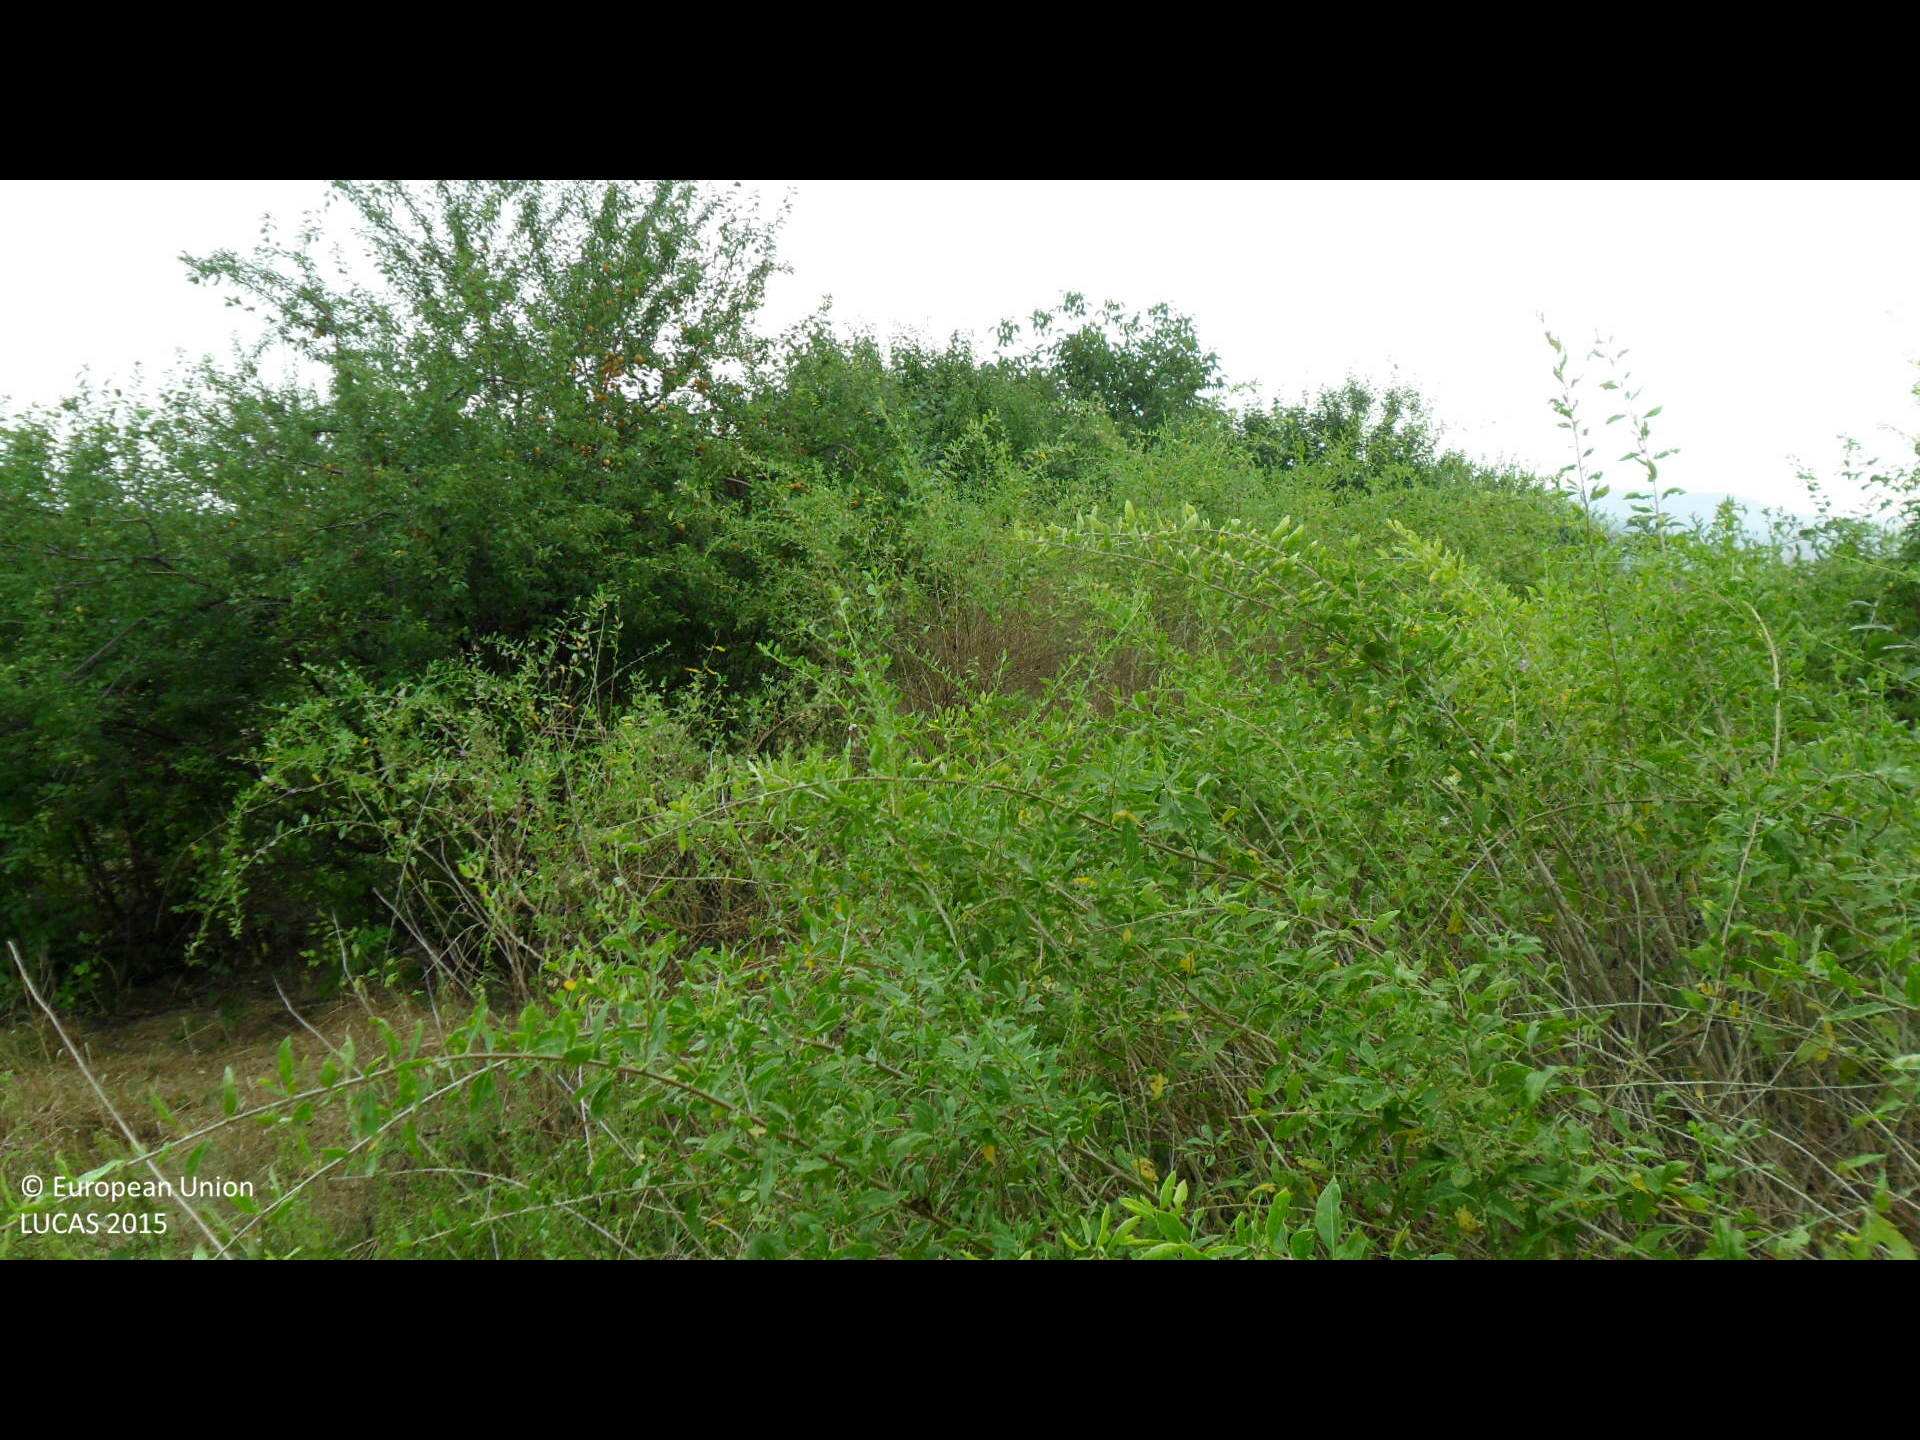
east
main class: Shrubland
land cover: Shrubland with sparse tree cover
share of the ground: > 75 %
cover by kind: shrubs 95 %, broadleaved forest trees 5 %
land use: Semi-natural and natural areas not in use
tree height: < 5 m
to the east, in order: Shrubland with sparse tree cover; Grassland with sparse tree/shrub cover; Grassland without tree/shrub cover
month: July
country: BG
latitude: 43.3537
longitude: 26.2469
